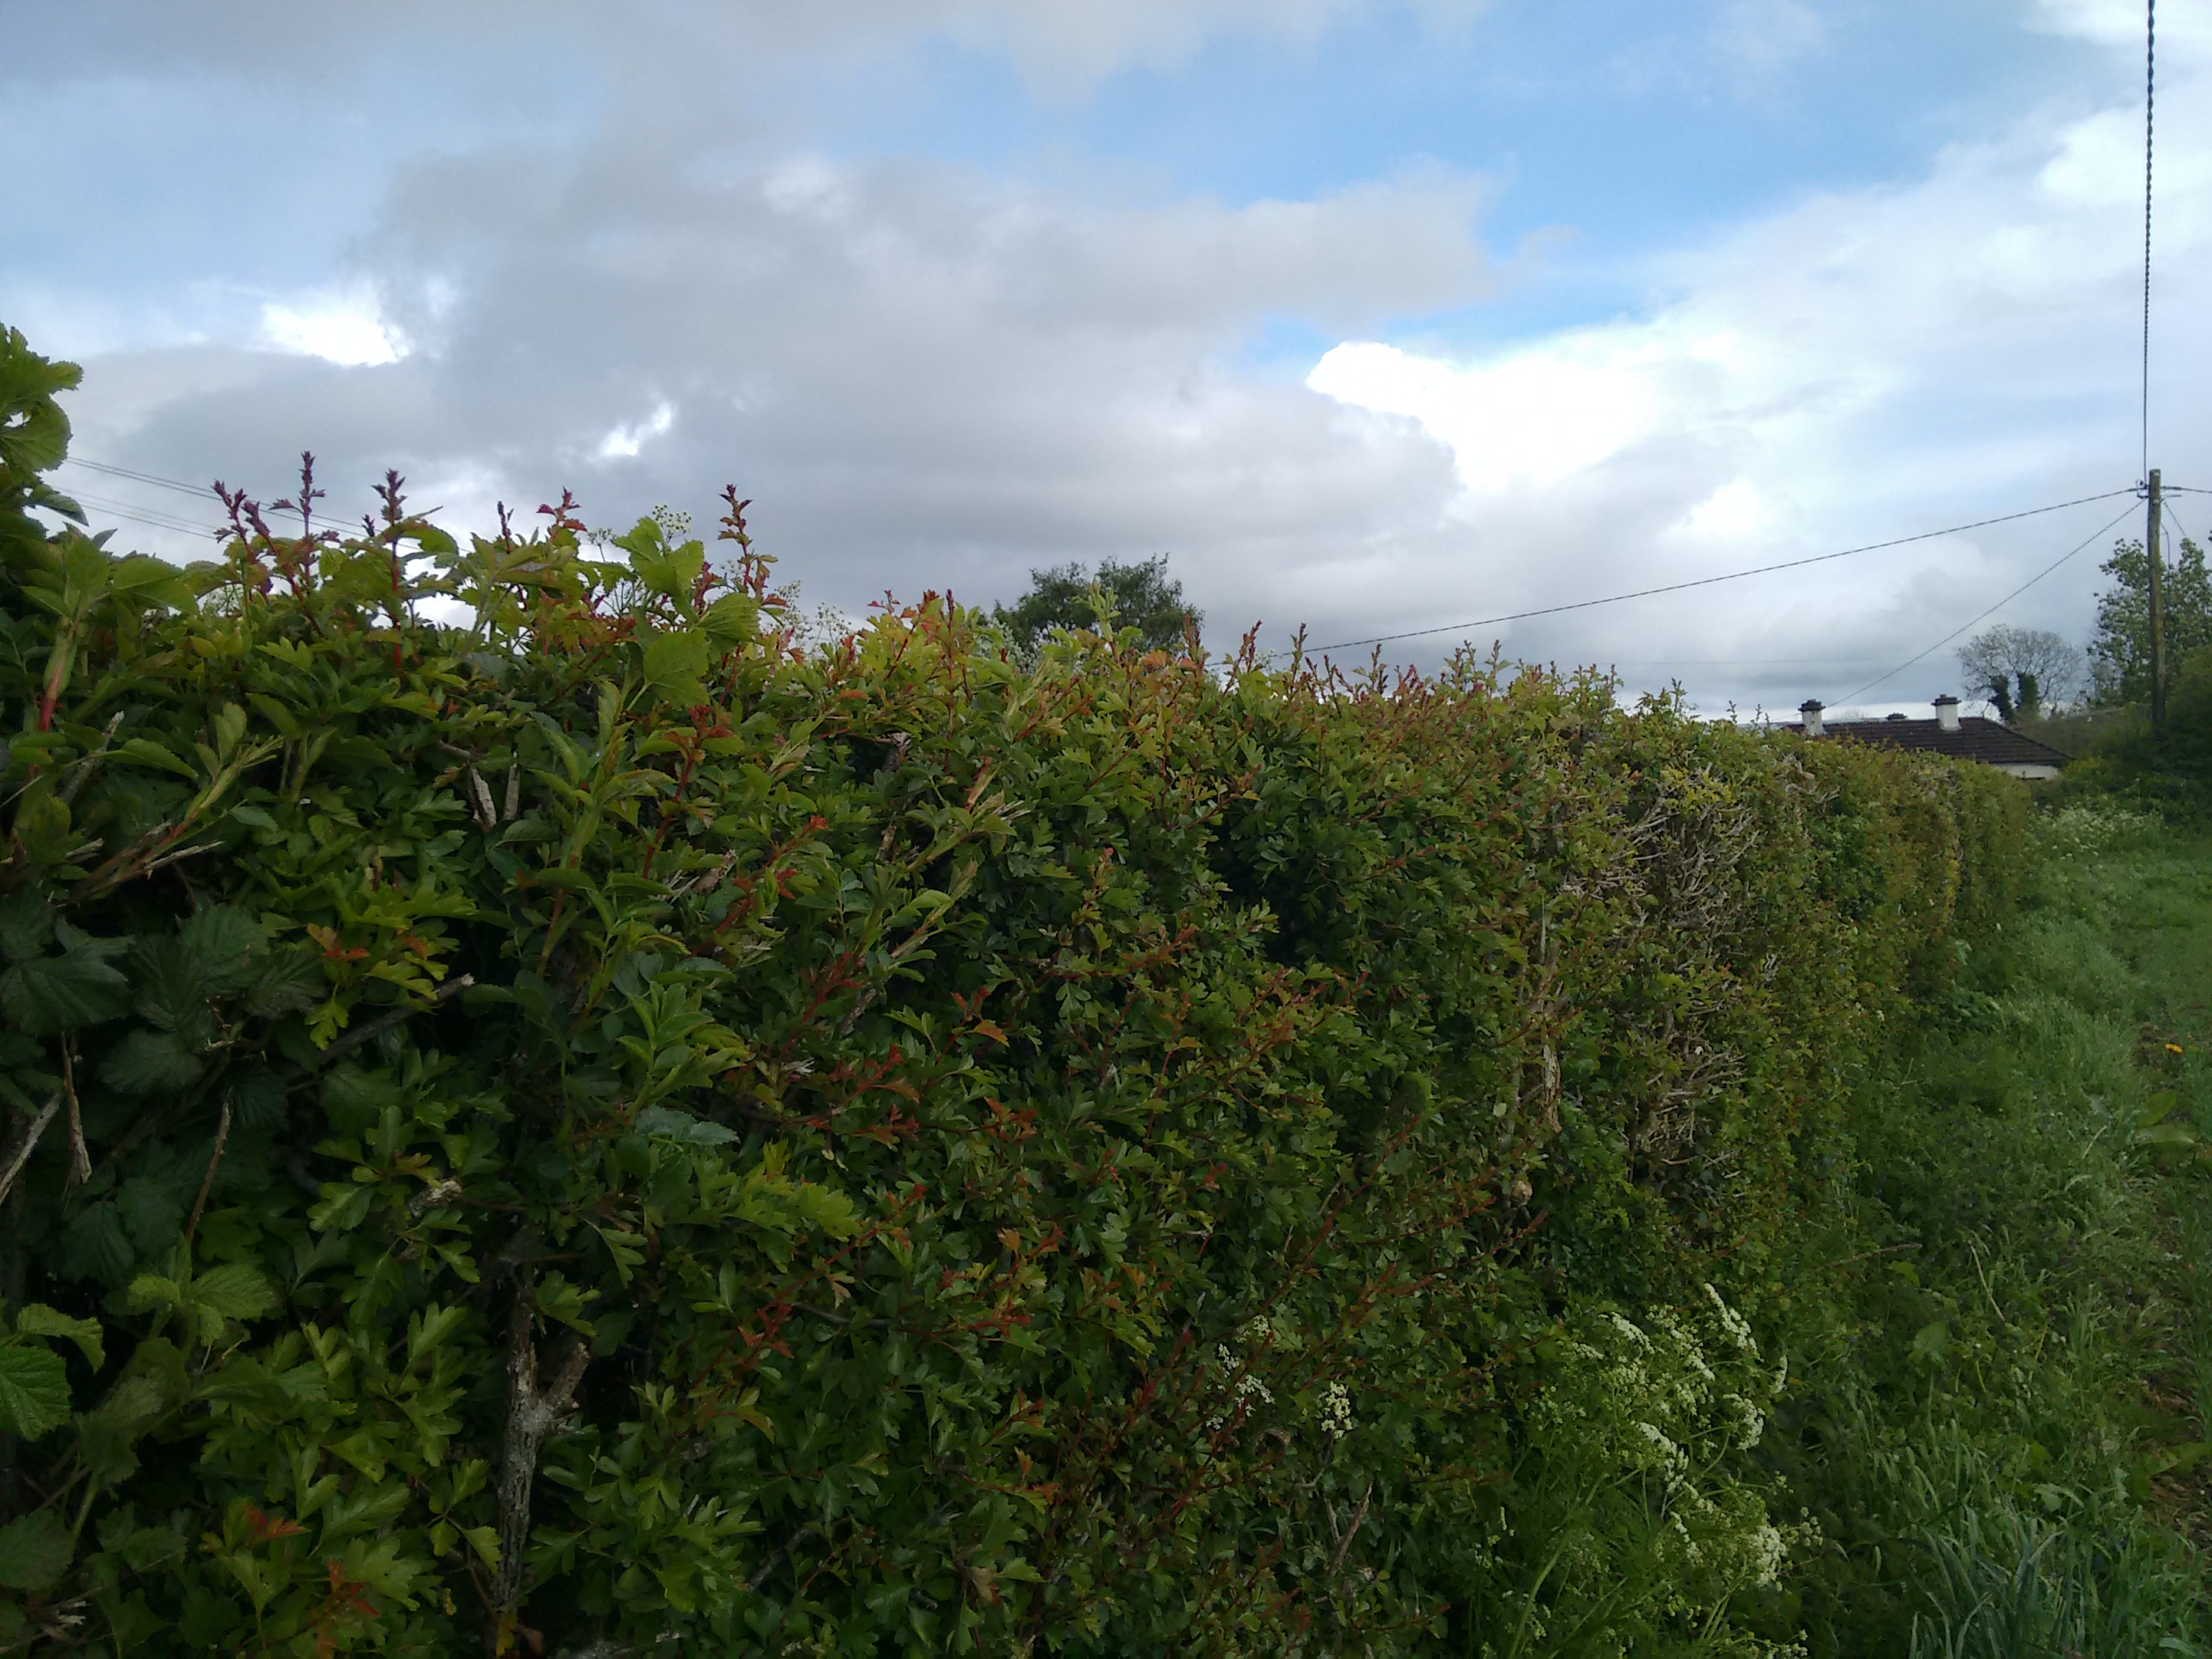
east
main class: Cropland
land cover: Barley
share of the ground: 50 - 75 %
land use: Agriculture (excluding fallow land and kitchen gardens)
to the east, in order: Barley; Managed hedges; Grass margins; Artificial constructions in urban areas; Grassland without tree/shrub cover
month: May
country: IE
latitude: 53.3421
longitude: -6.6376
